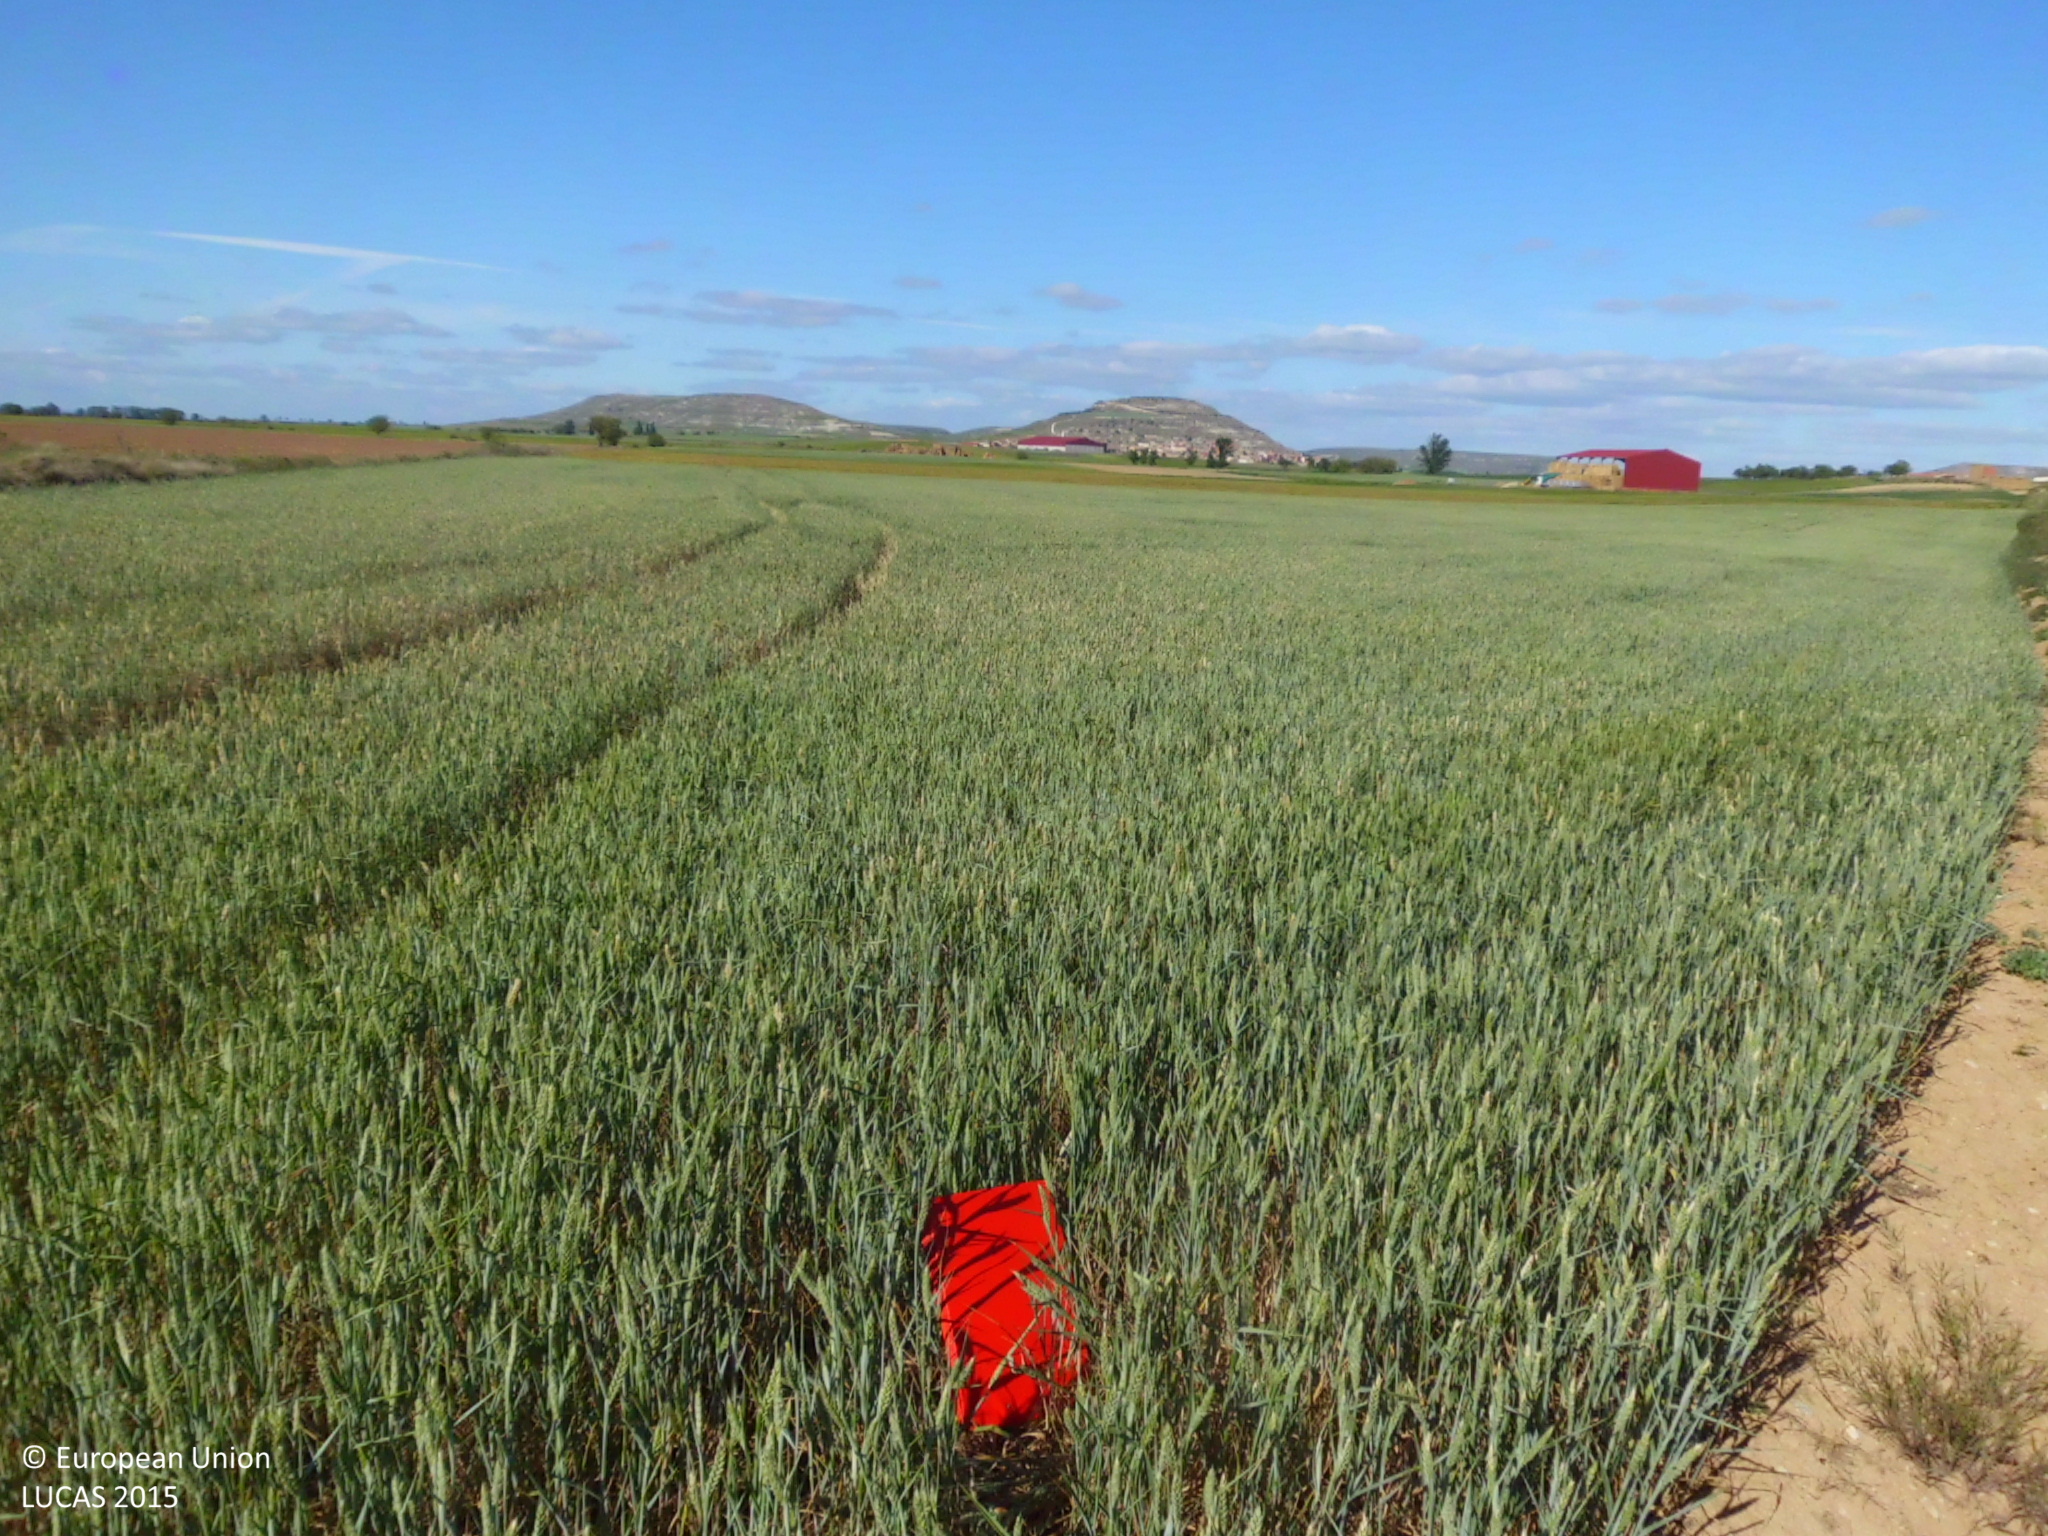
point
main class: Cropland
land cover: Common wheat
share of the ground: > 75 %
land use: Agriculture (excluding fallow land and kitchen gardens)
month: May
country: ES
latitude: 42.2747
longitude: -4.1687
